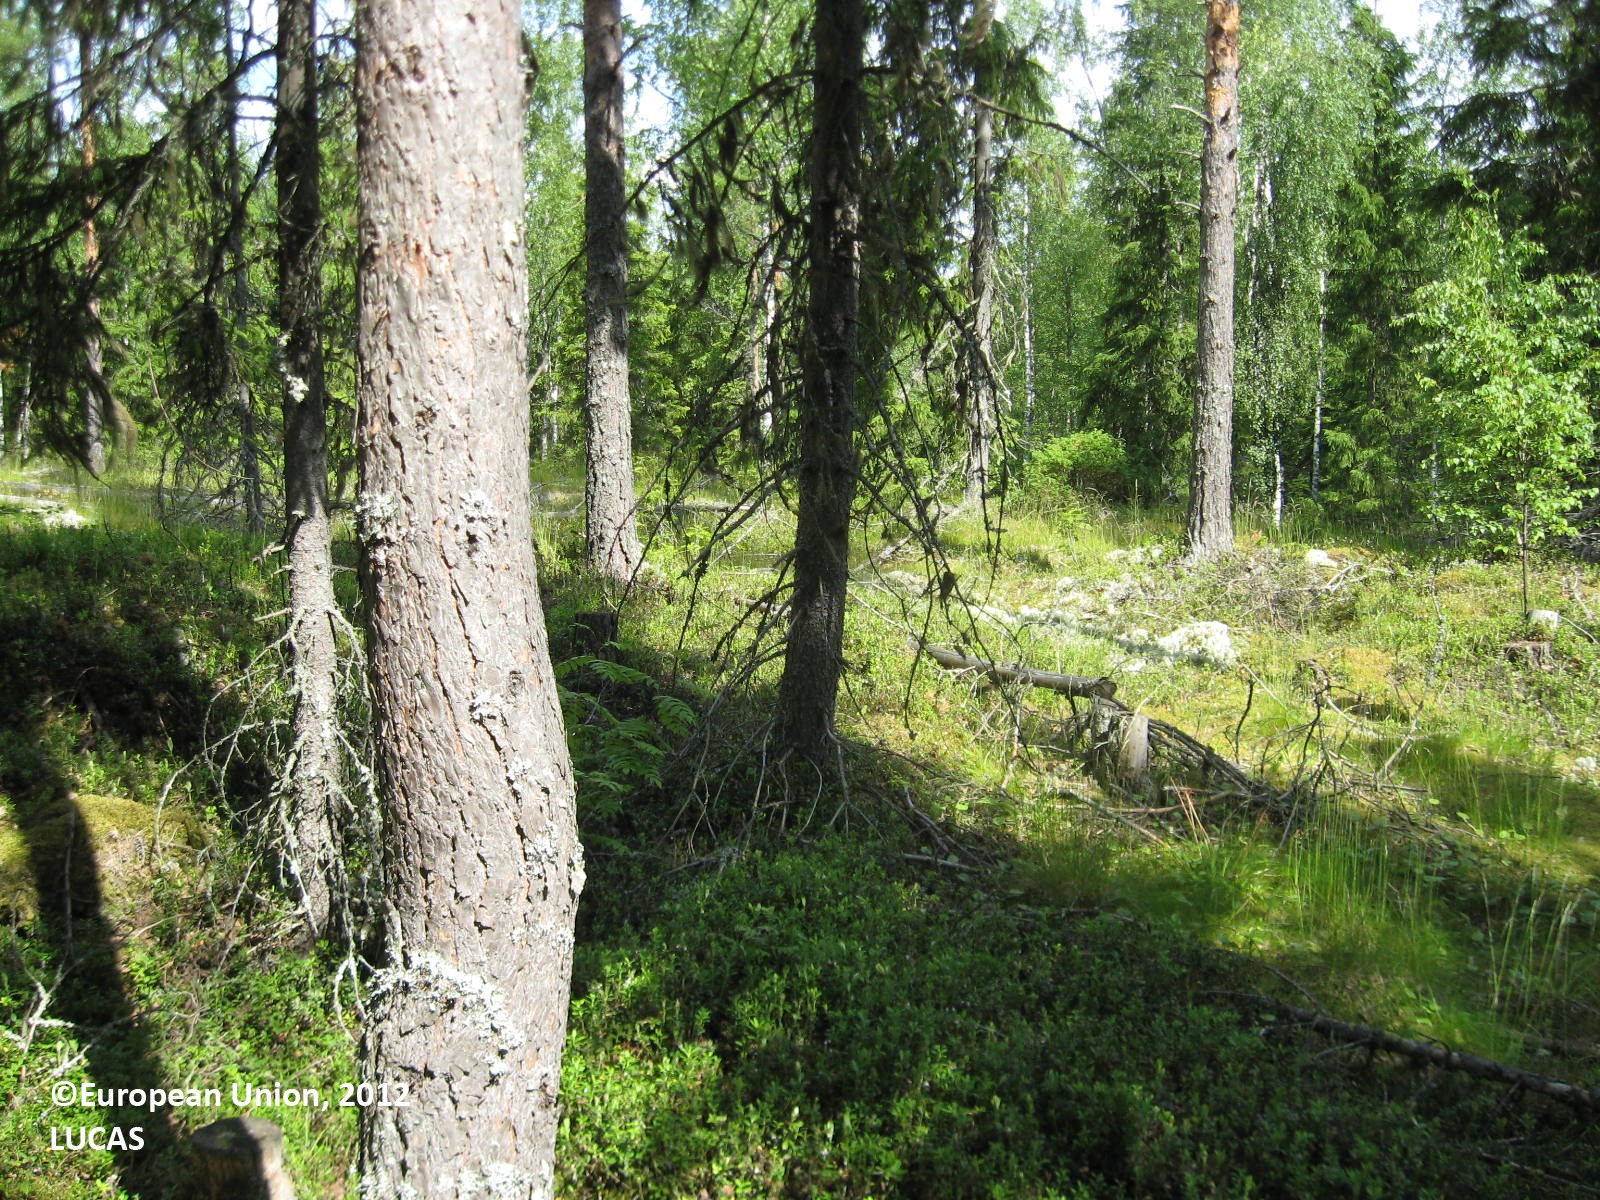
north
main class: Woodland
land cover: Spruce dominated mixed woodland
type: boreal forest
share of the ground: 50 - 75 %
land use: Forestry
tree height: > 5 m
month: July
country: FI
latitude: 62.6270
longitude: 22.6311
